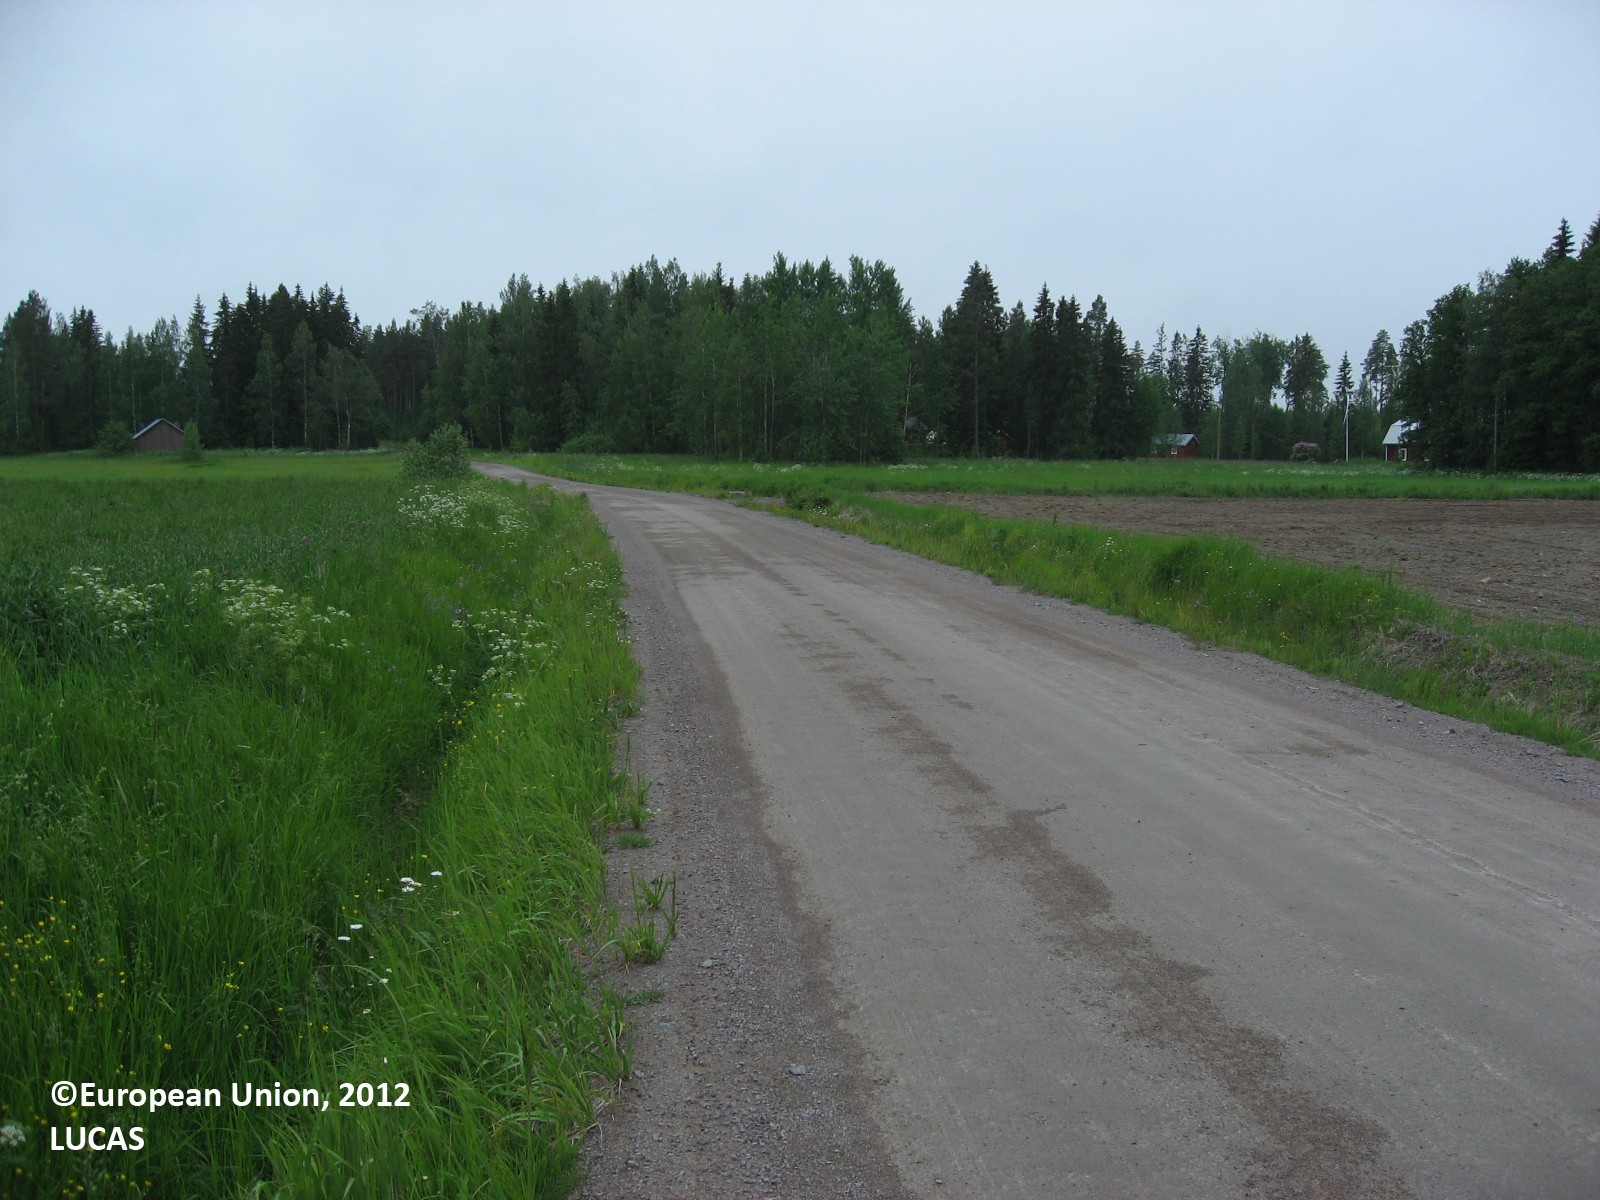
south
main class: Cropland
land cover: Clovers
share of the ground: > 75 %
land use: Agriculture (excluding fallow land and kitchen gardens)
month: June
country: FI
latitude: 60.5174
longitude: 26.2699
